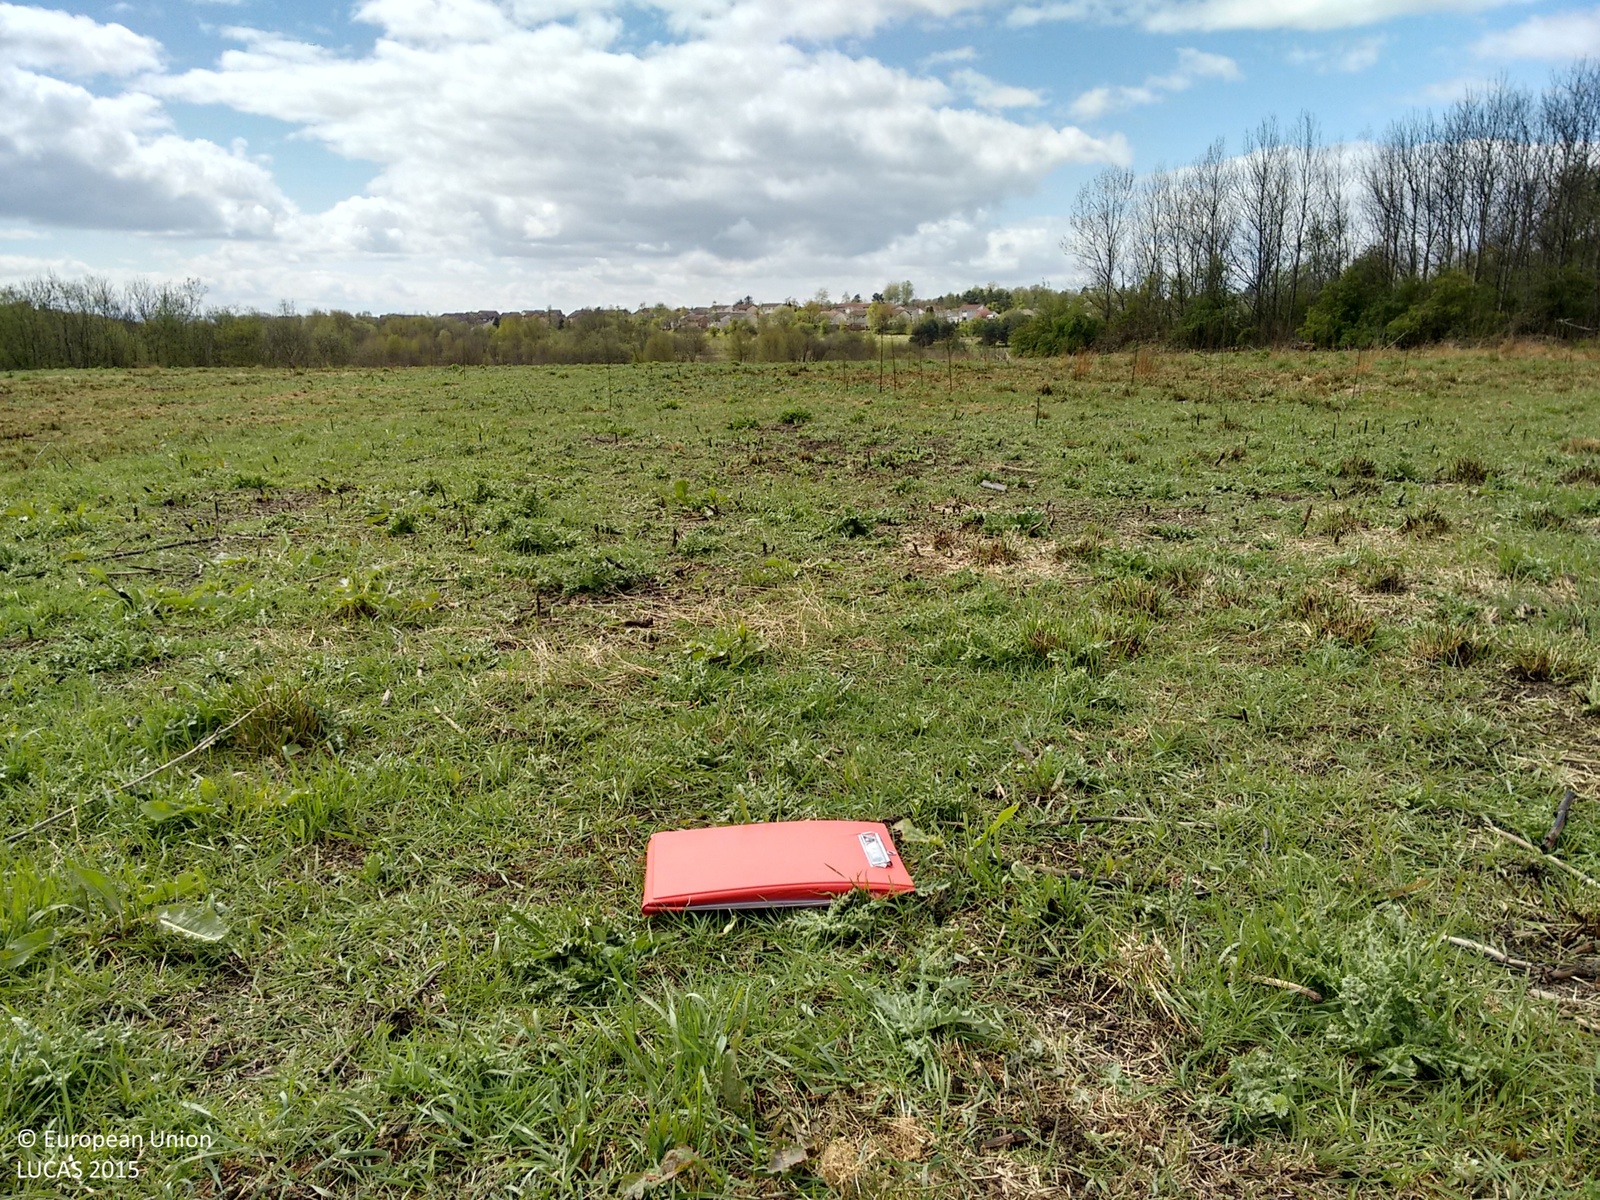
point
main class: Grassland
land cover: Grassland without tree/shrub cover
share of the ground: > 75 %
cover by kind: herbaceous plants 95 %, unconsolidated bare surface 5 %
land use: Amenities, museums, leisure
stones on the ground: < 10 %
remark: Burnt area
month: May
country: GB
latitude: 55.8570
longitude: -3.9701
